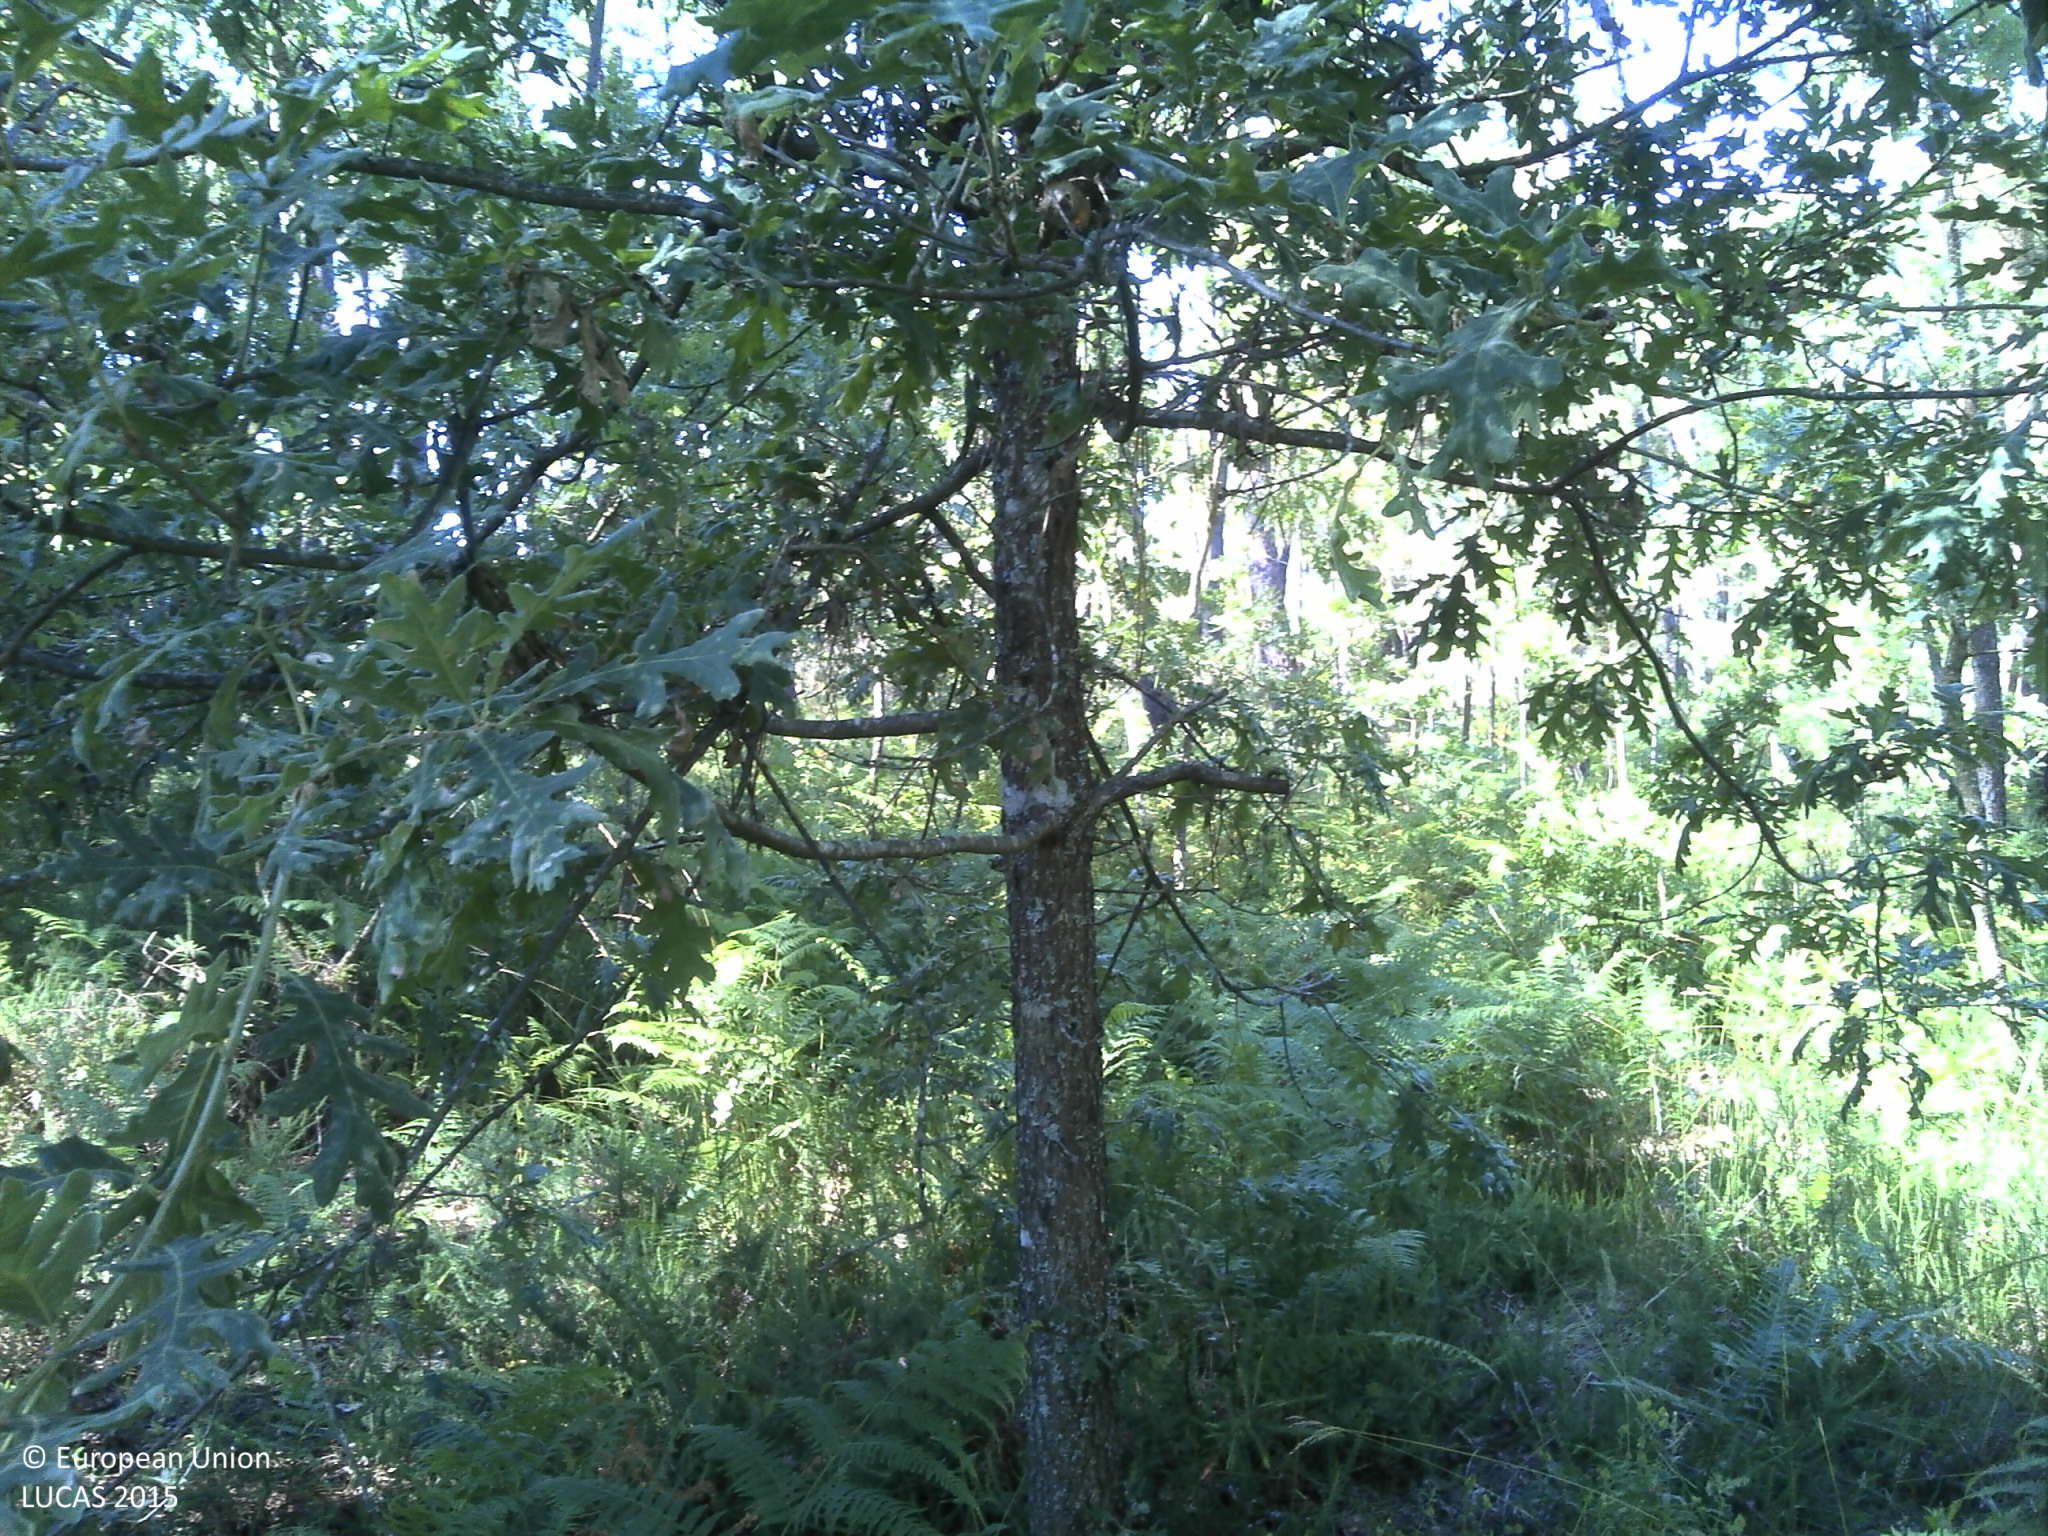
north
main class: Woodland
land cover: Broadleaved woodland
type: thermophilous deciduous forest
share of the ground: 50 - 75 %
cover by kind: broadleaved forest trees 70 %, unconsolidated bare surface 15 %, shrubs 10 %, coniferous forest trees 5 %
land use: Forestry
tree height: > 5 m
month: June
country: PT
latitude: 40.7046
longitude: -7.9388
